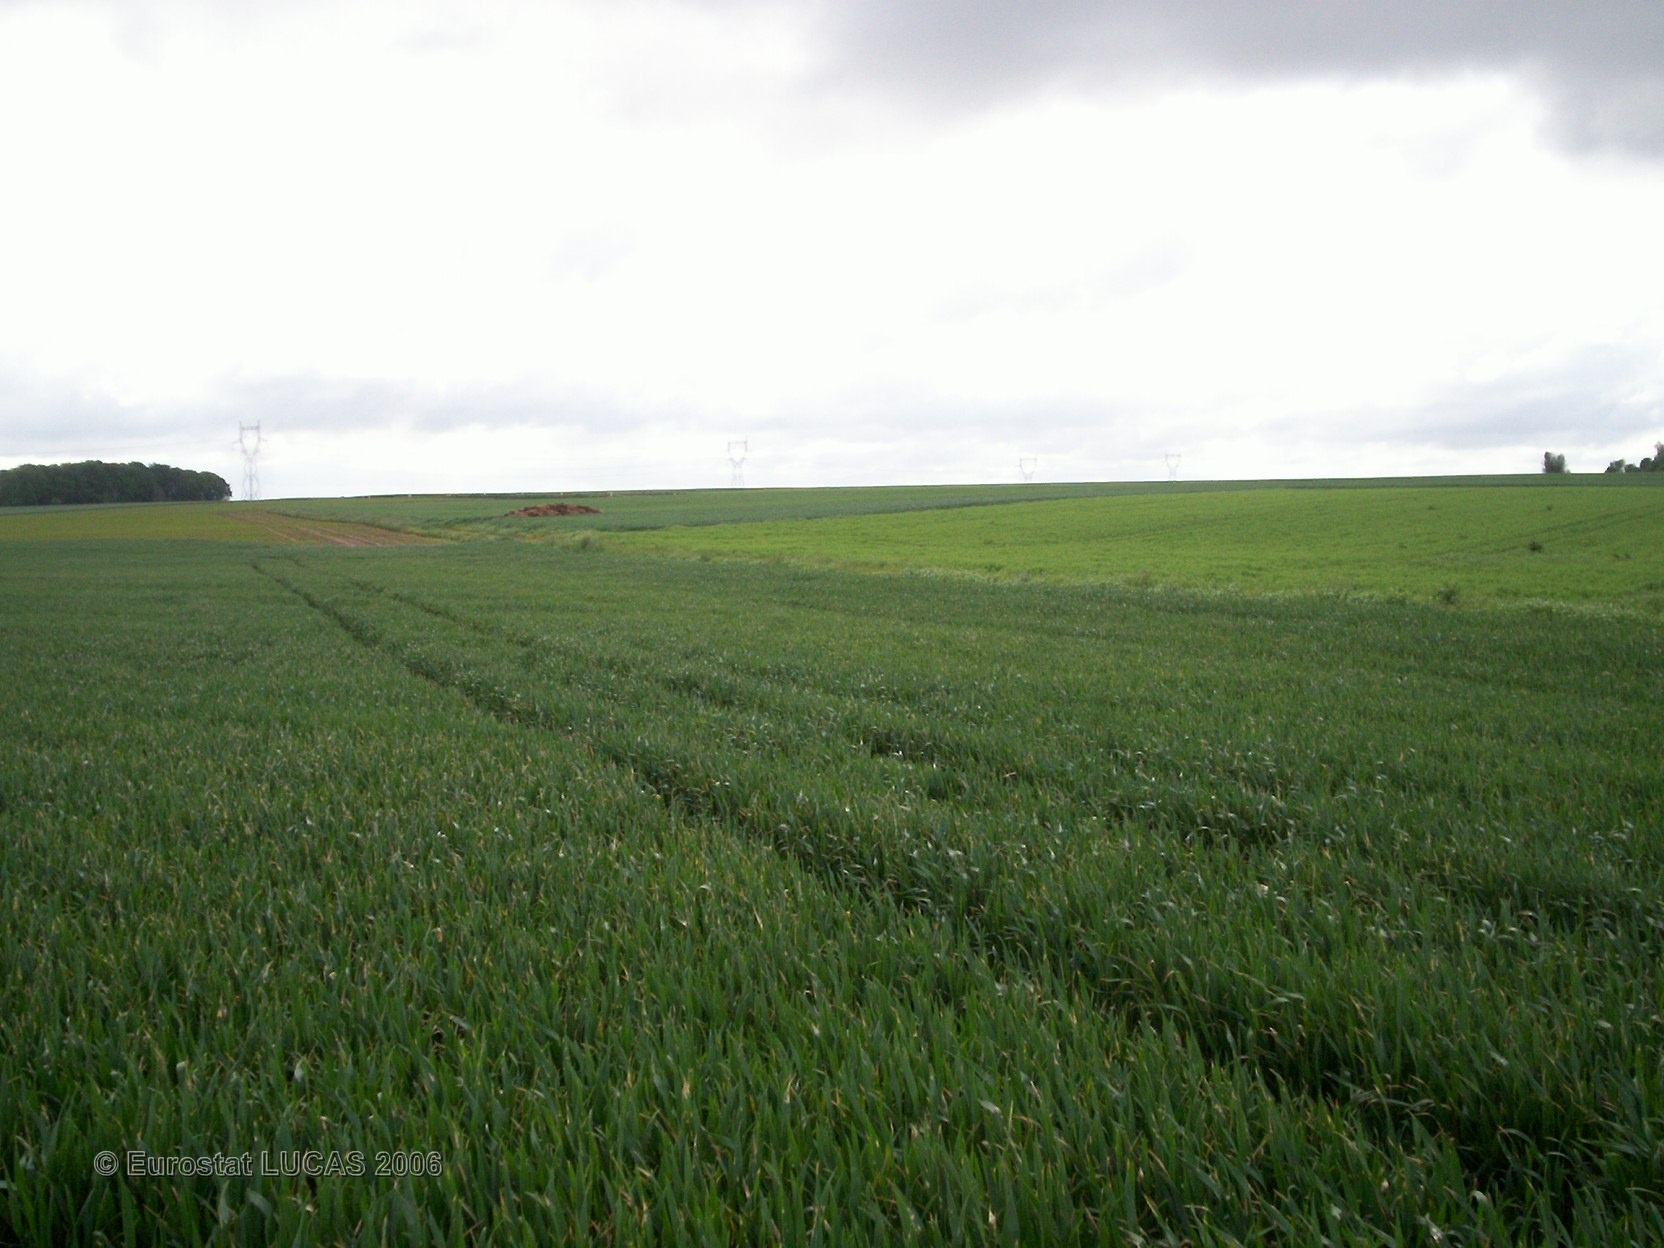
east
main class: Cropland
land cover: Common wheat
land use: Agriculture (excluding fallow land and kitchen gardens)
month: May
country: FR
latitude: 50.1110
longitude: 2.6752
